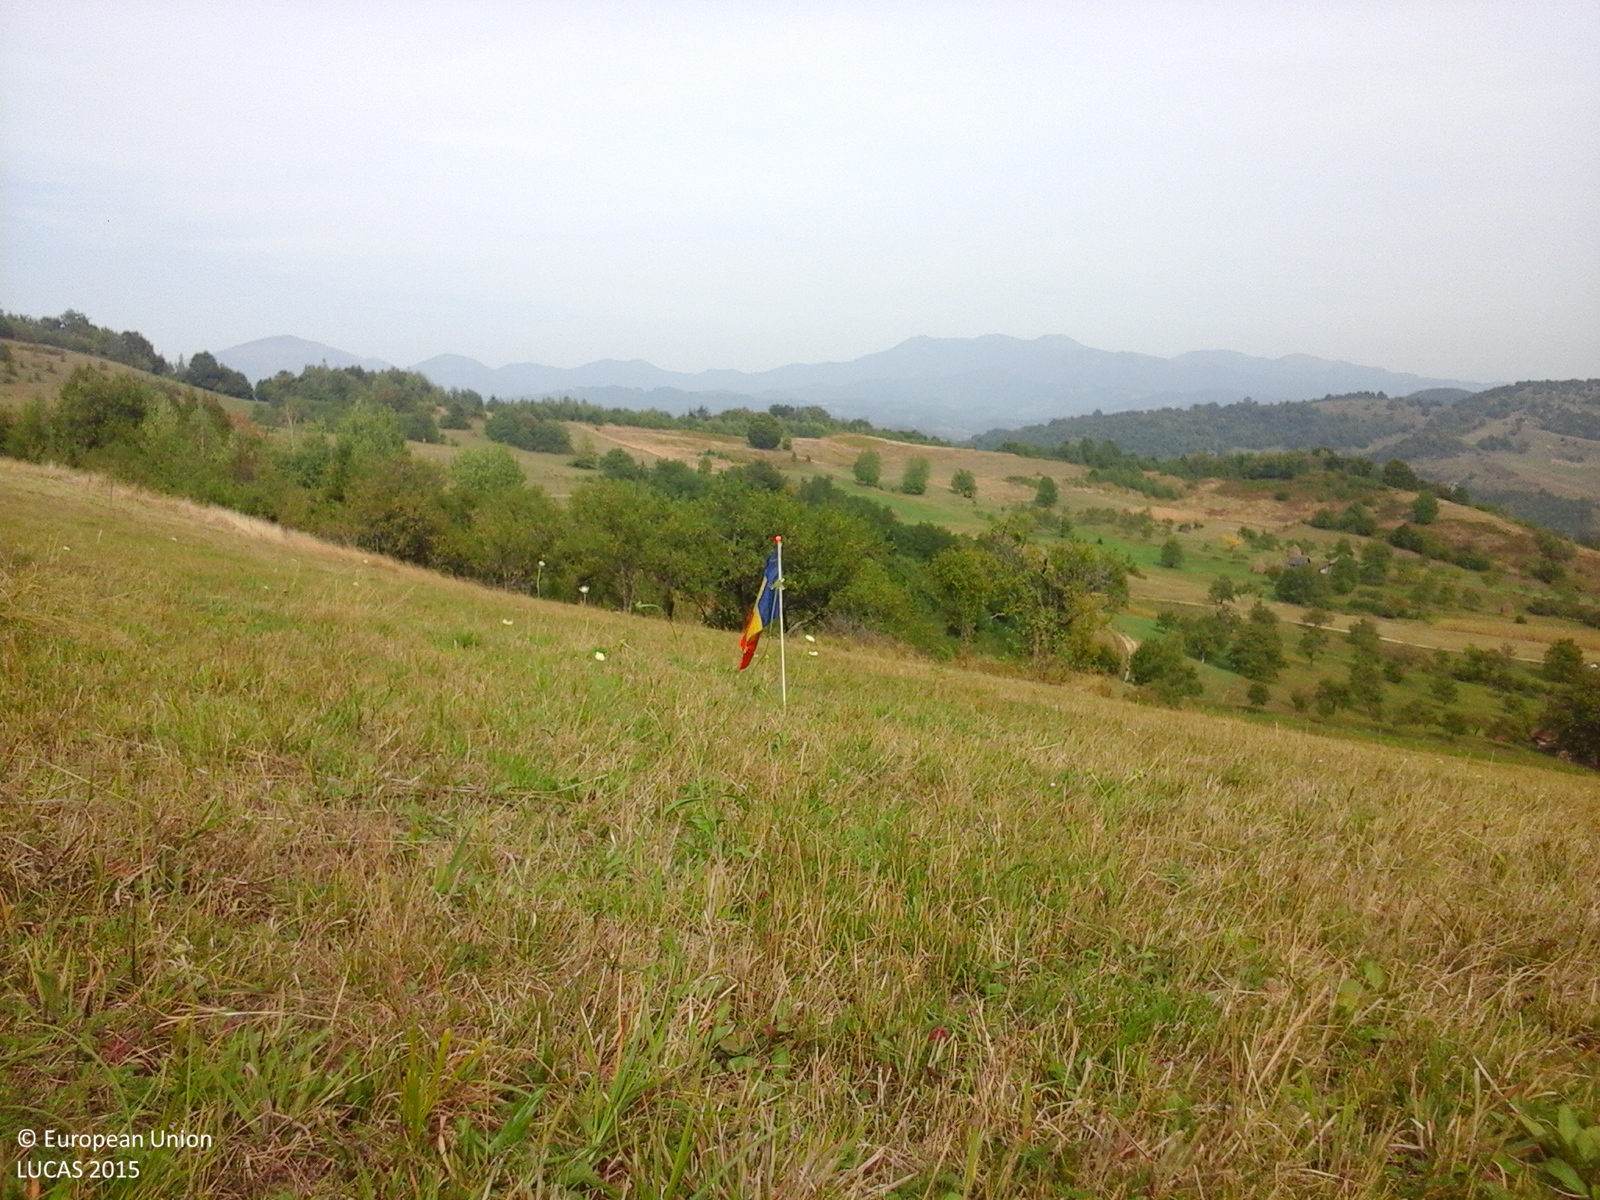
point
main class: Grassland
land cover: Grassland without tree/shrub cover
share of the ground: > 75 %
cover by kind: herbaceous plants 100 %
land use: Agriculture (excluding fallow land and kitchen gardens)
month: September
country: RO
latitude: 47.4143
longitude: 24.0126
